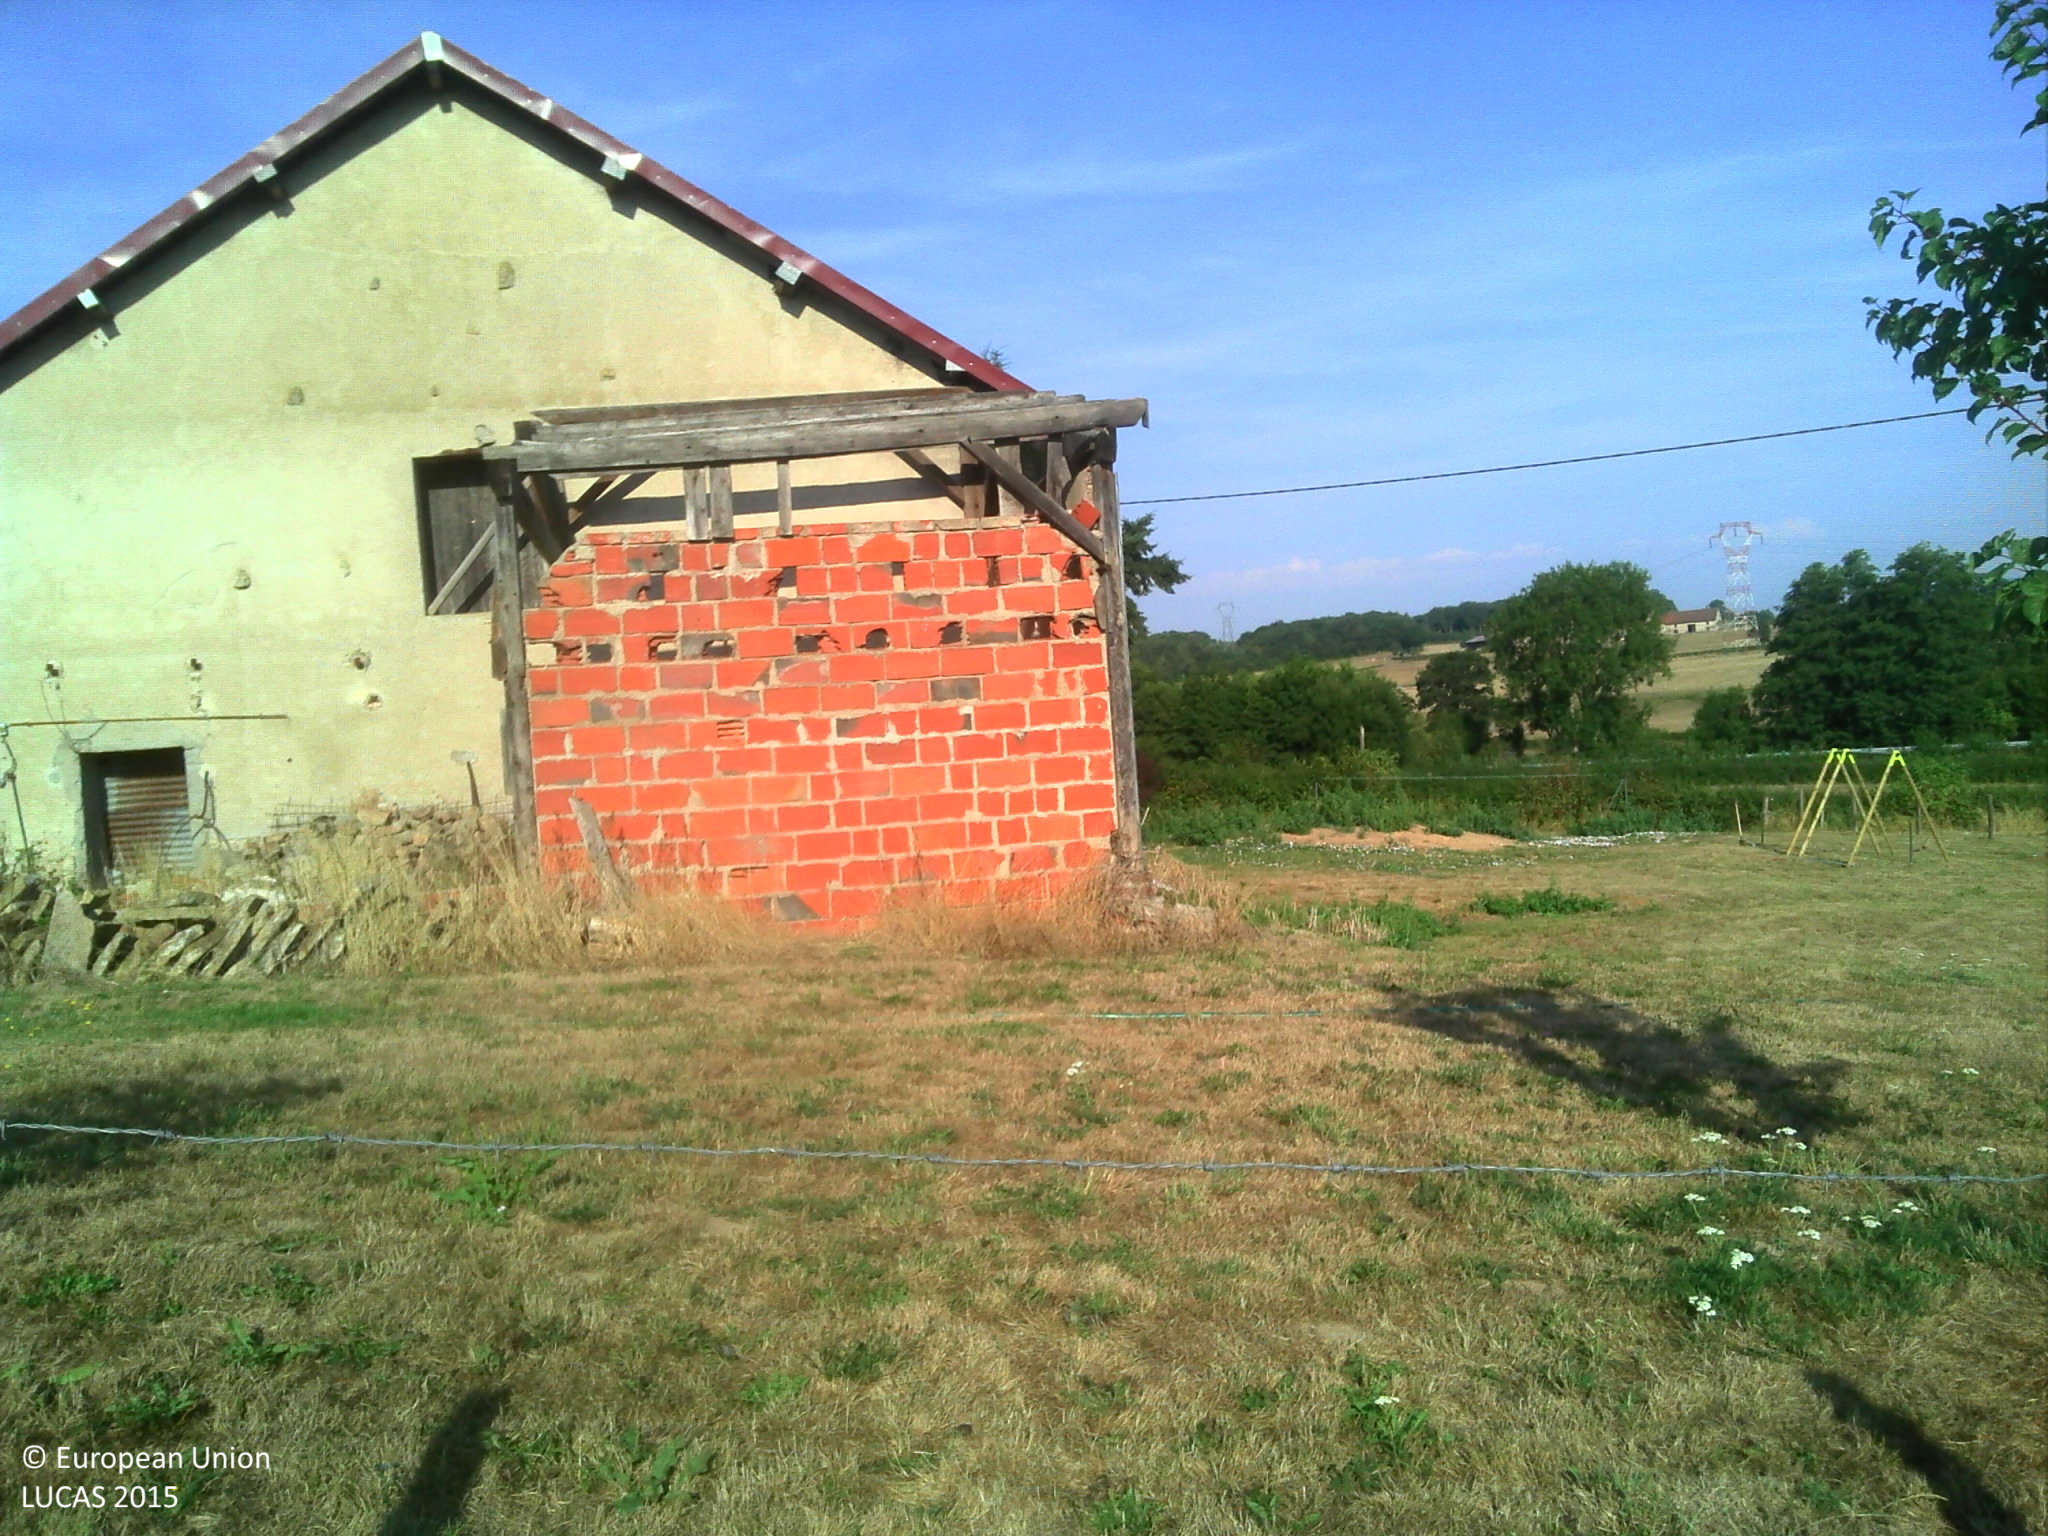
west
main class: Grassland
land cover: Grassland without tree/shrub cover
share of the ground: > 75 %
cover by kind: herbaceous plants 100 %
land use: Agriculture (excluding fallow land and kitchen gardens)
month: August
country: FR
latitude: 46.7121
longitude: 4.4412
